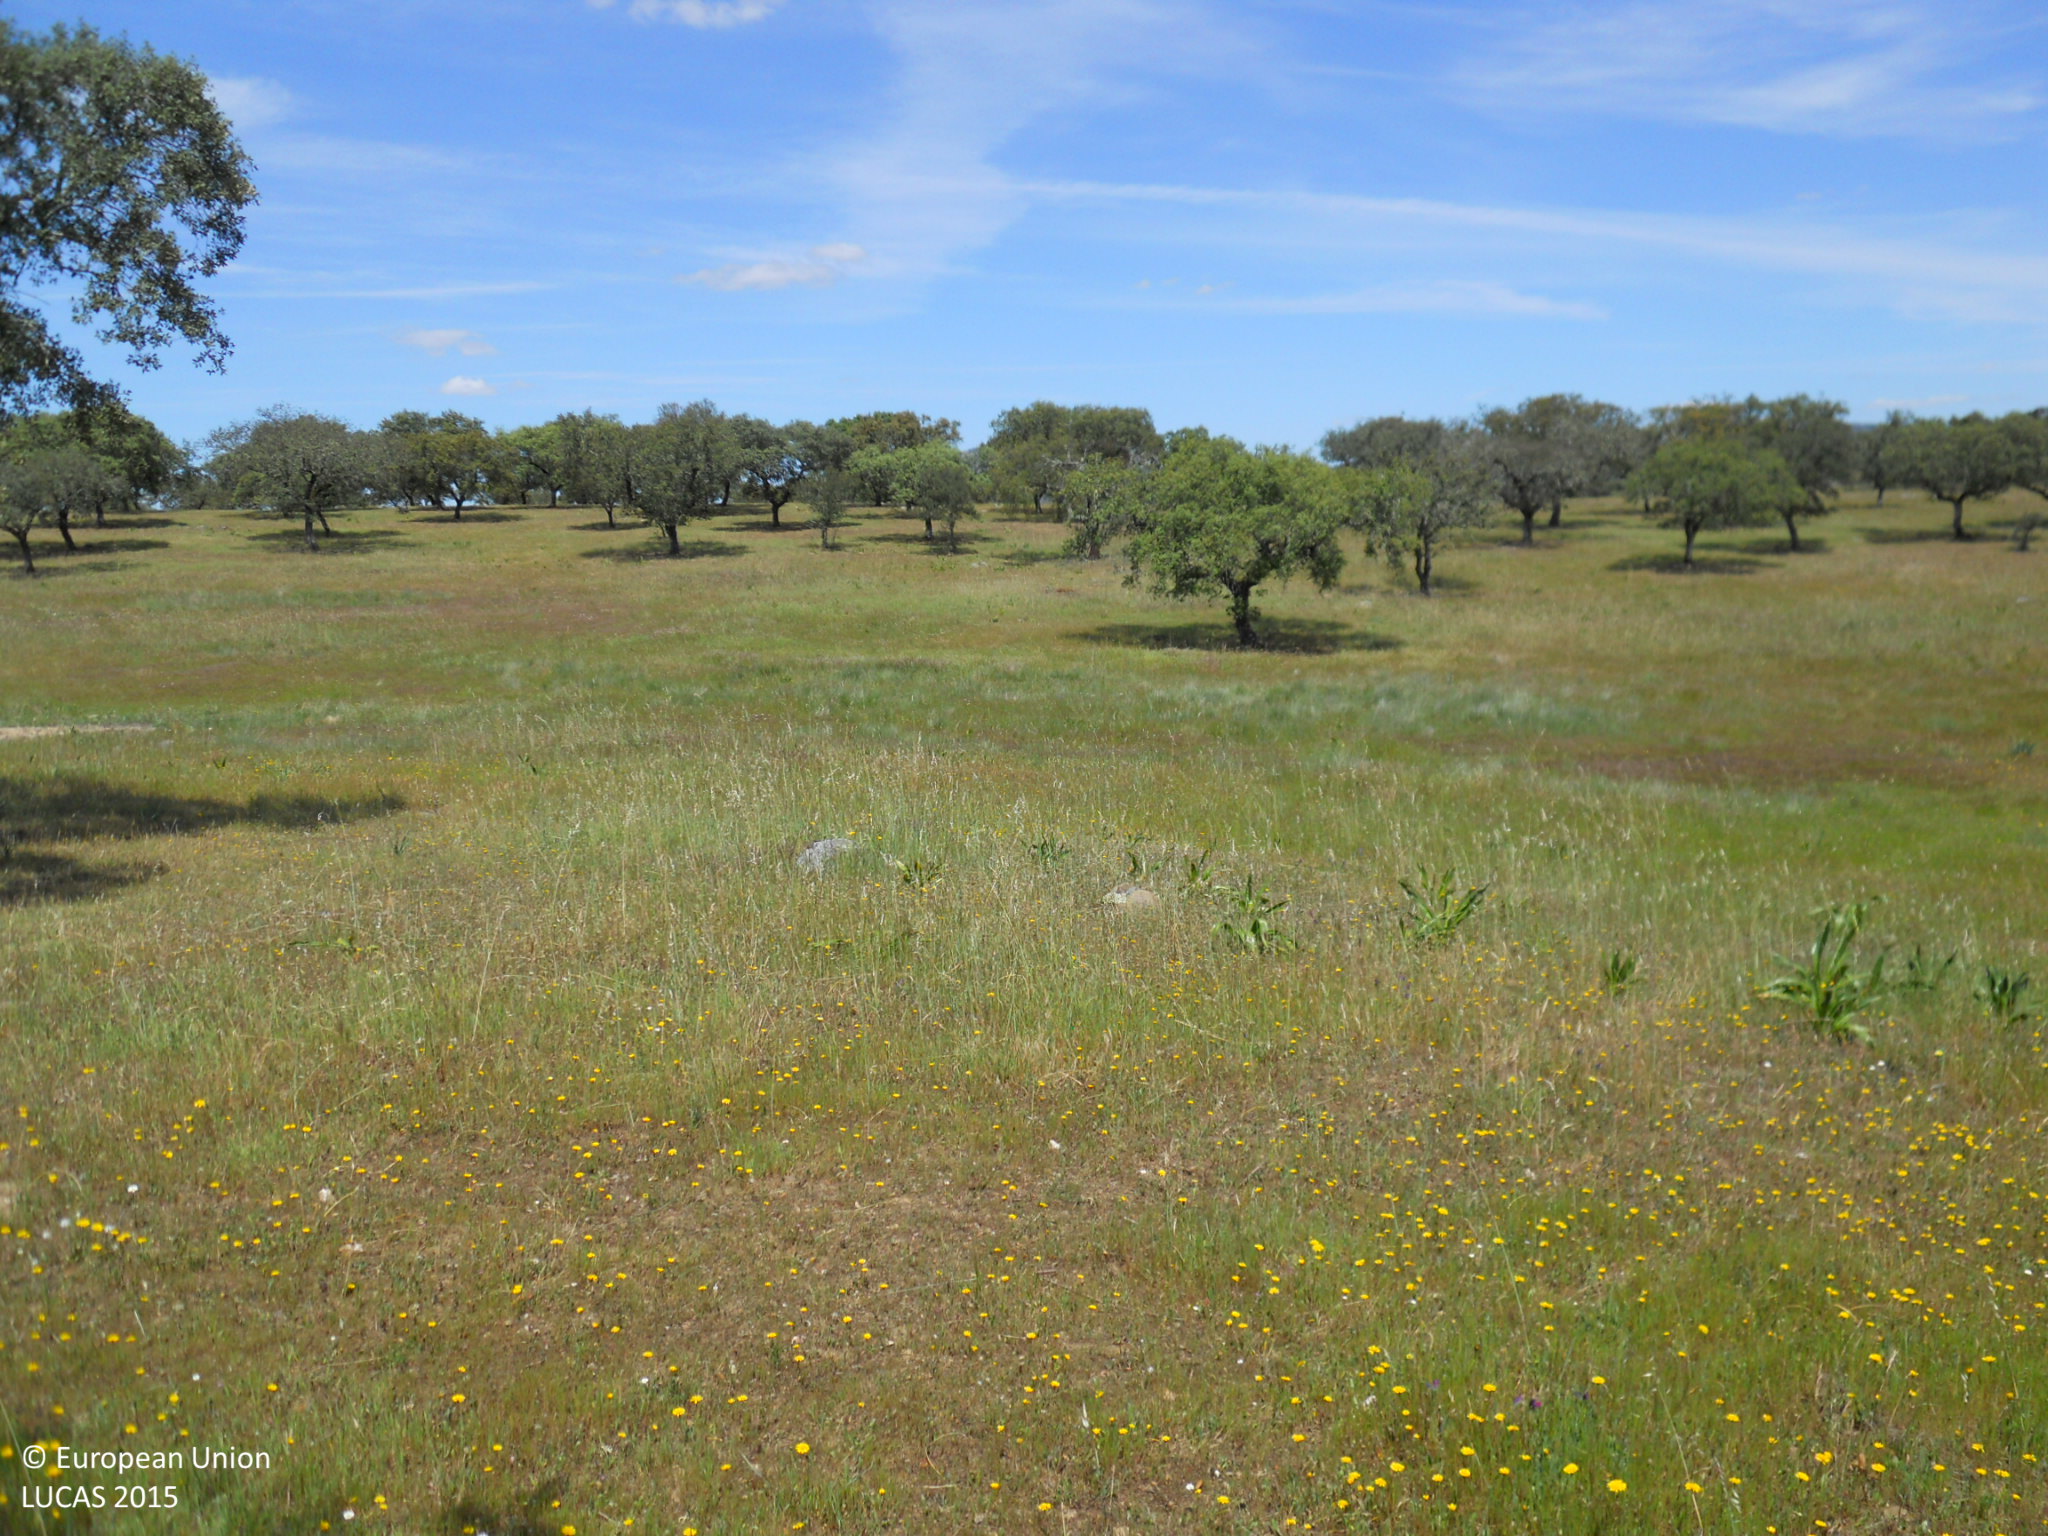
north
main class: Woodland
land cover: Broadleaved woodland
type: broadleaved evergreen forest
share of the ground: 10 - 25 %
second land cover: Grassland without tree/shrub cover
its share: > 75 %
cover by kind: herbaceous plants 70 %, broadleaved forest trees 20 %, unconsolidated bare surface 10 %
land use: Forestry
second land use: Agriculture (excluding fallow land and kitchen gardens)
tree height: > 5 m
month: April
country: ES
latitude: 39.3634
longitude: -6.9894
